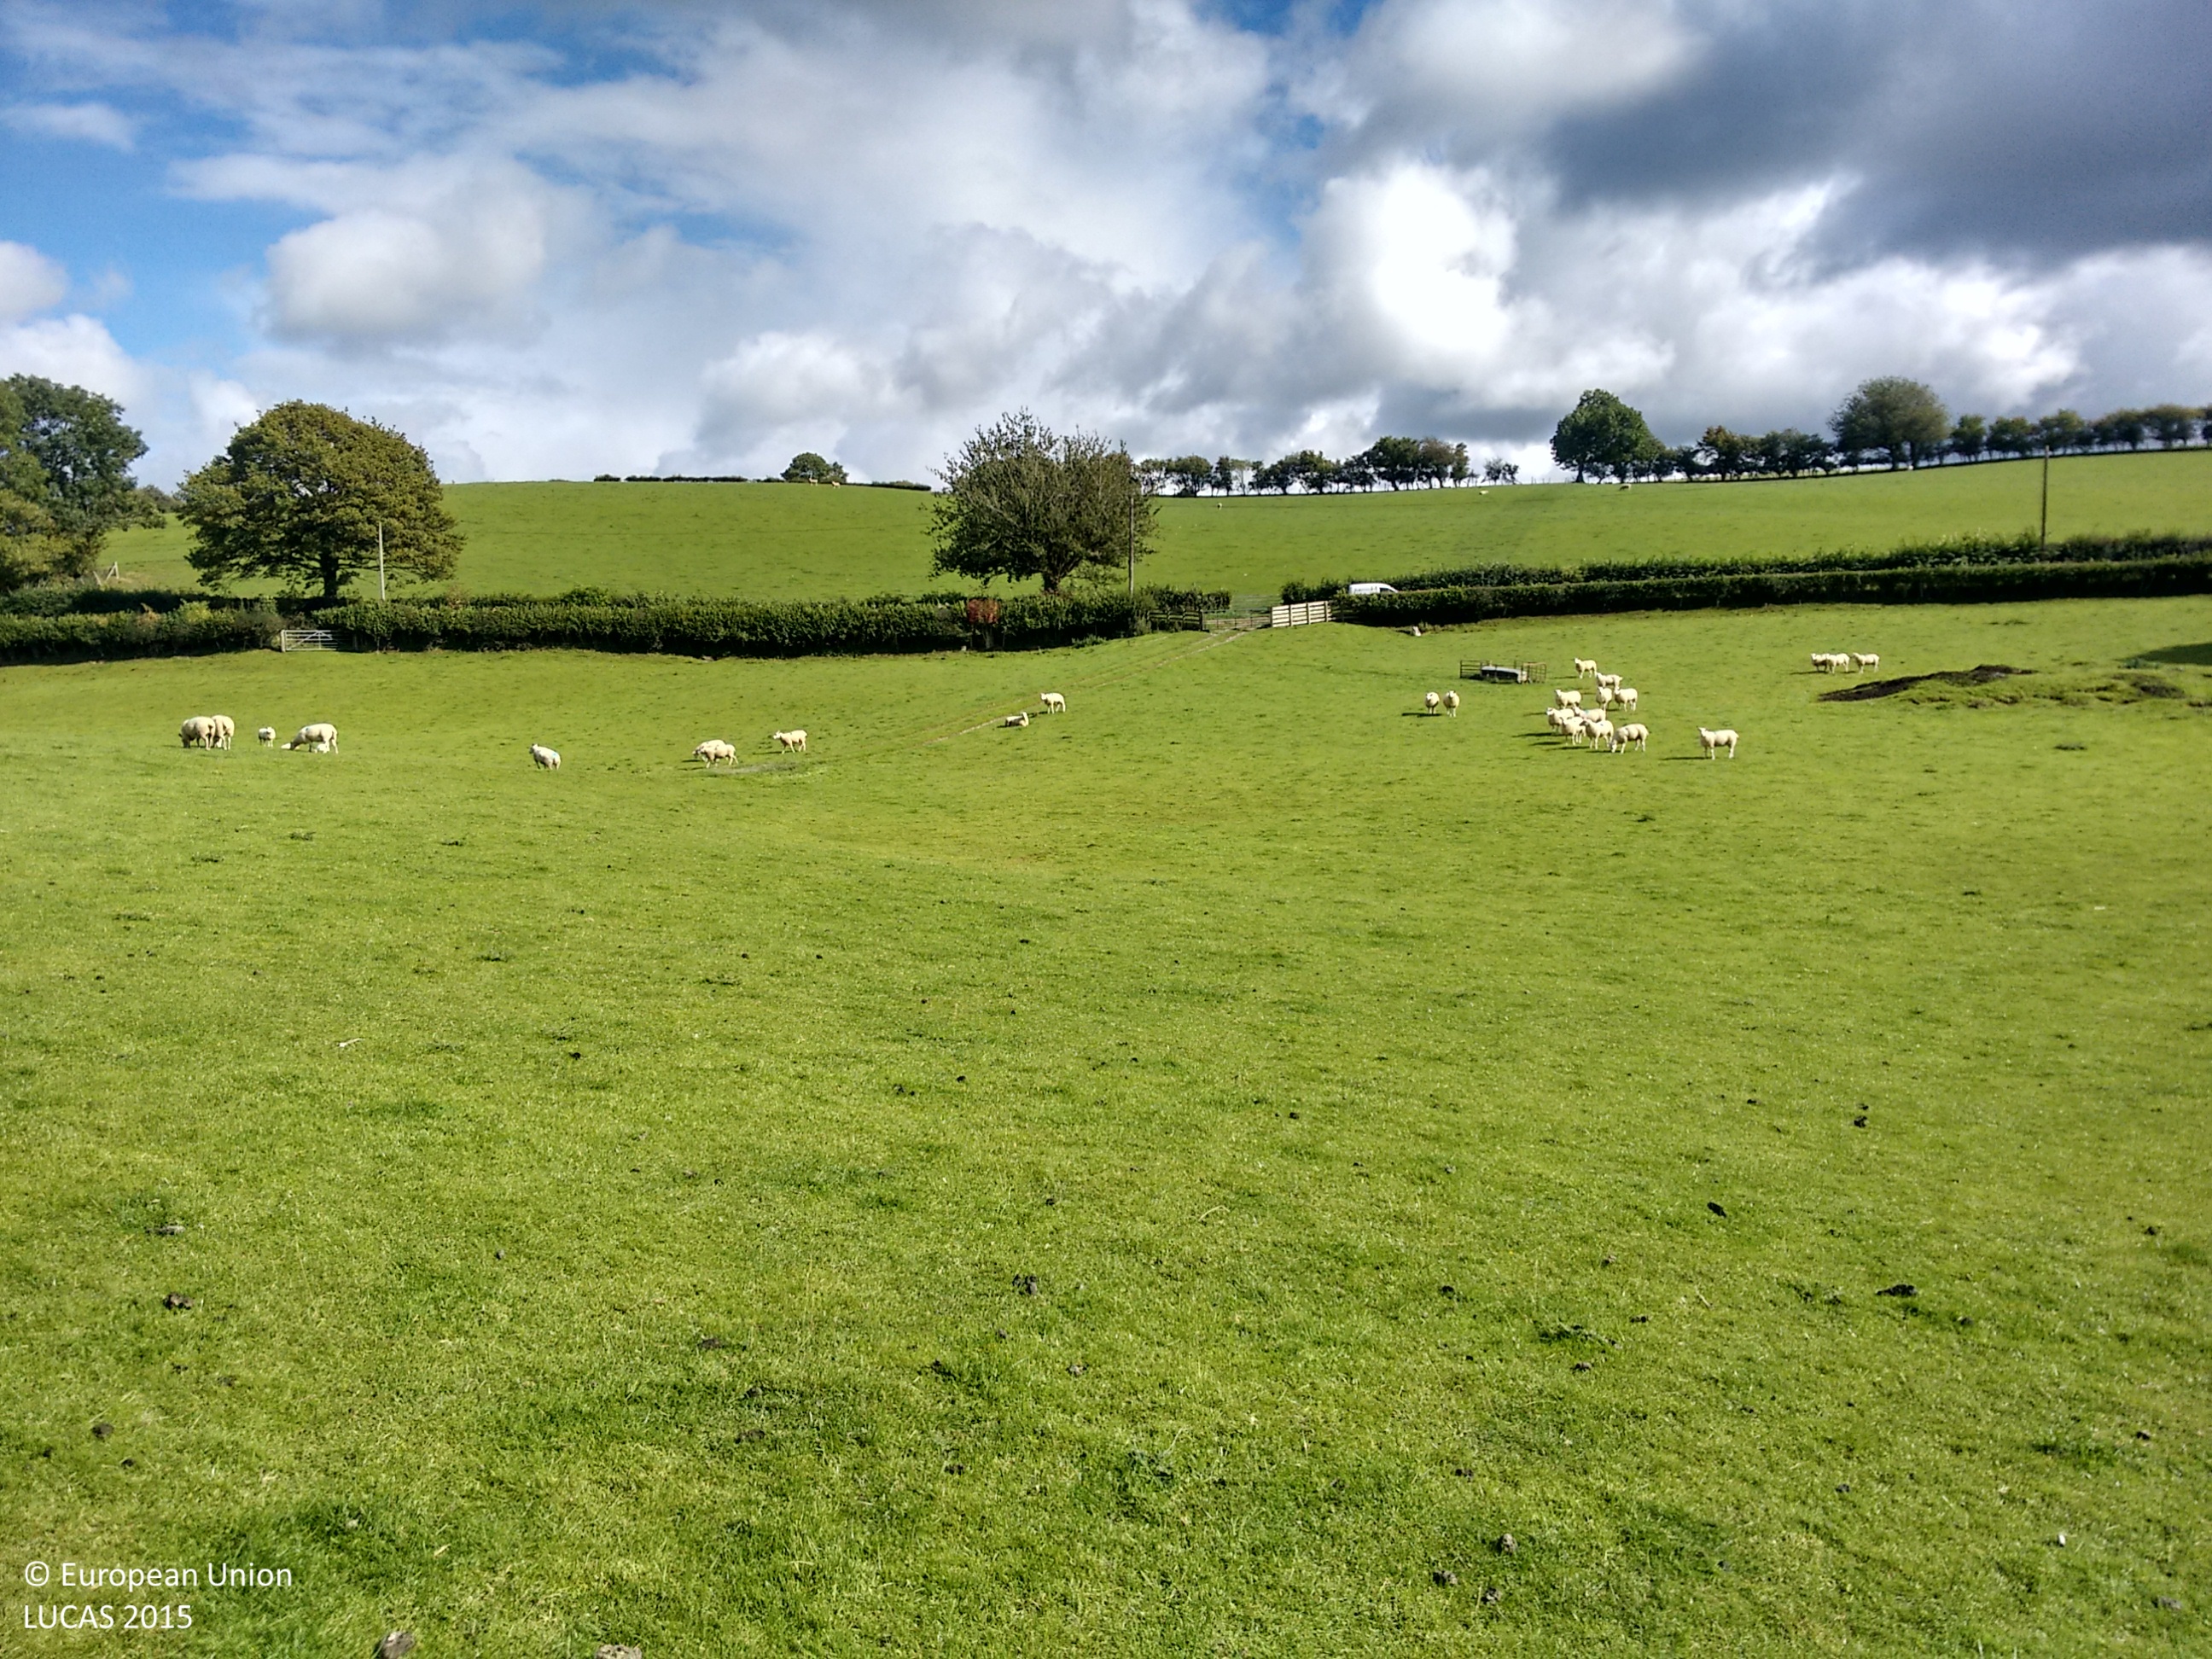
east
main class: Grassland
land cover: Grassland without tree/shrub cover
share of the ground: > 75 %
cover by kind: herbaceous plants 100 %
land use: Agriculture (excluding fallow land and kitchen gardens)
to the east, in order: Grassland without tree/shrub cover; Tracks; Grassland without tree/shrub cover; Managed hedges; Grass margins; Paved roads, cycling and walking lanes; Electric lines; Managed hedges; Grassland without tree/shrub cover
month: September
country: GB
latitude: 52.5743
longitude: -3.2866
